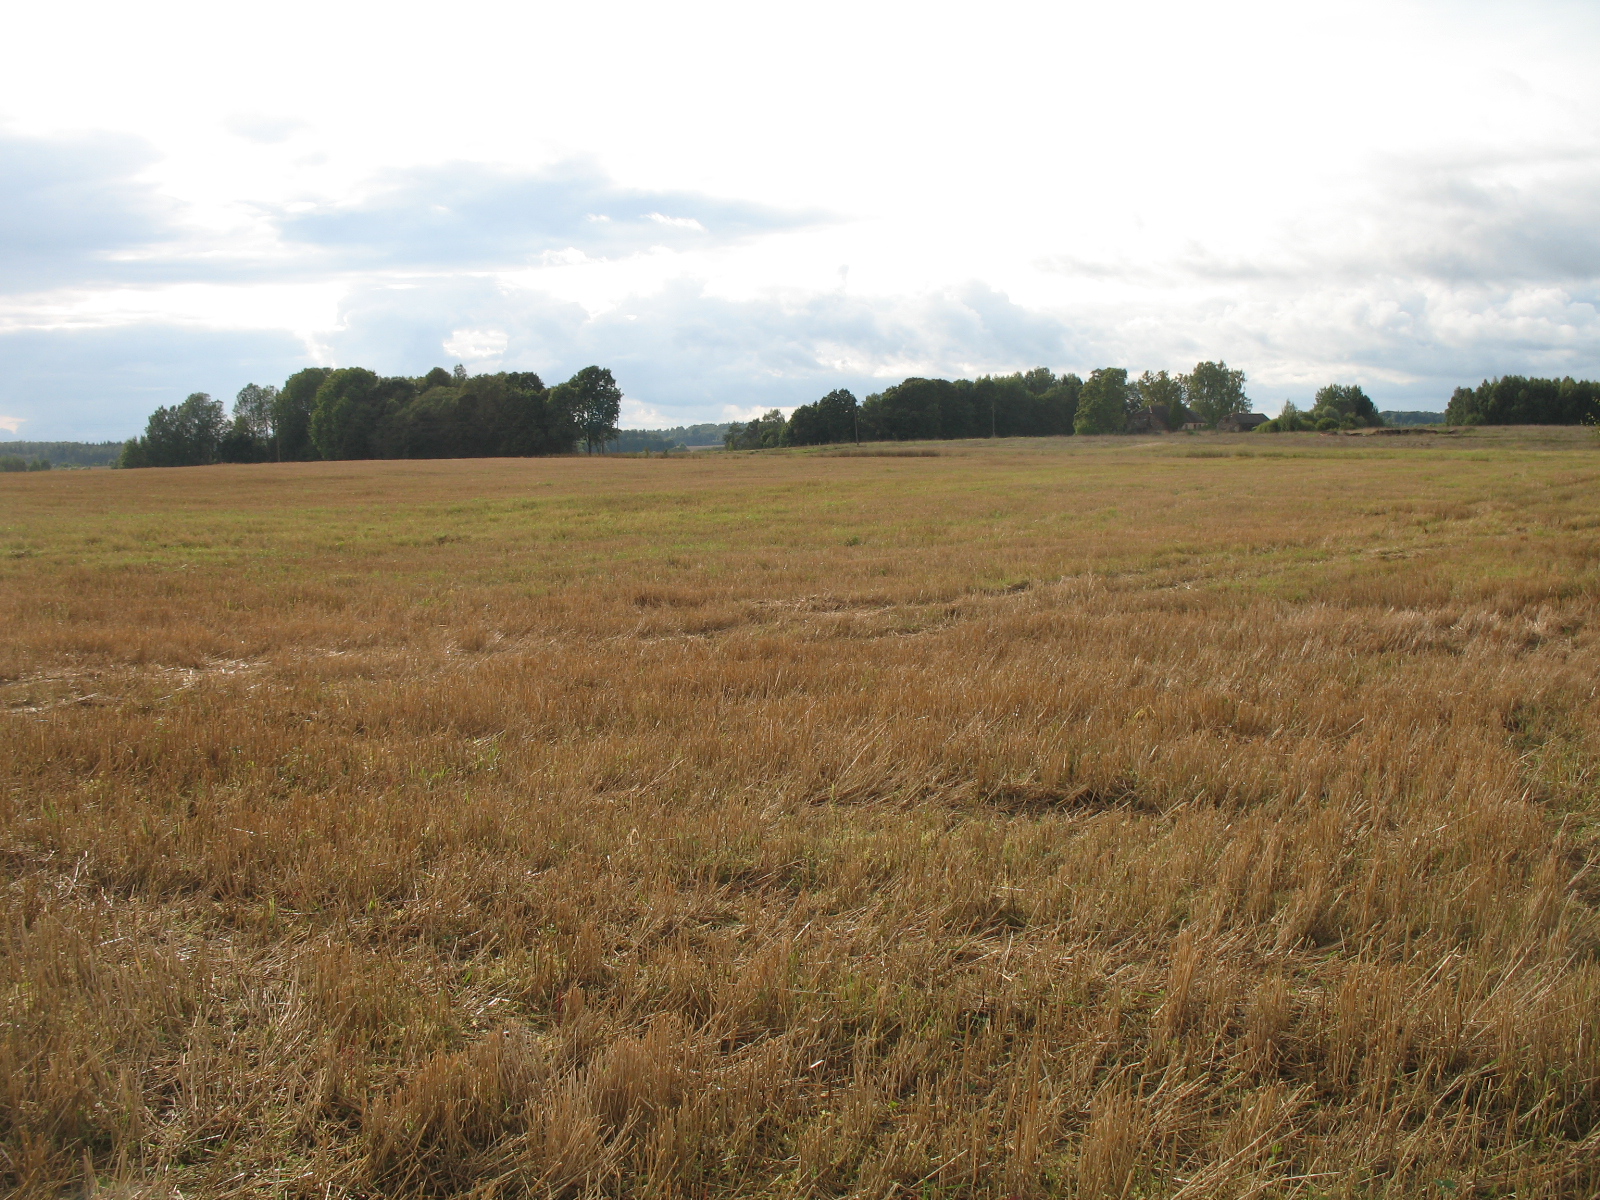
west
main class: Cropland
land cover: Common wheat
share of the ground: 10 - 25 %
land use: Agriculture (excluding fallow land and kitchen gardens)
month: September
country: LV
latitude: 56.0833
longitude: 25.9297
